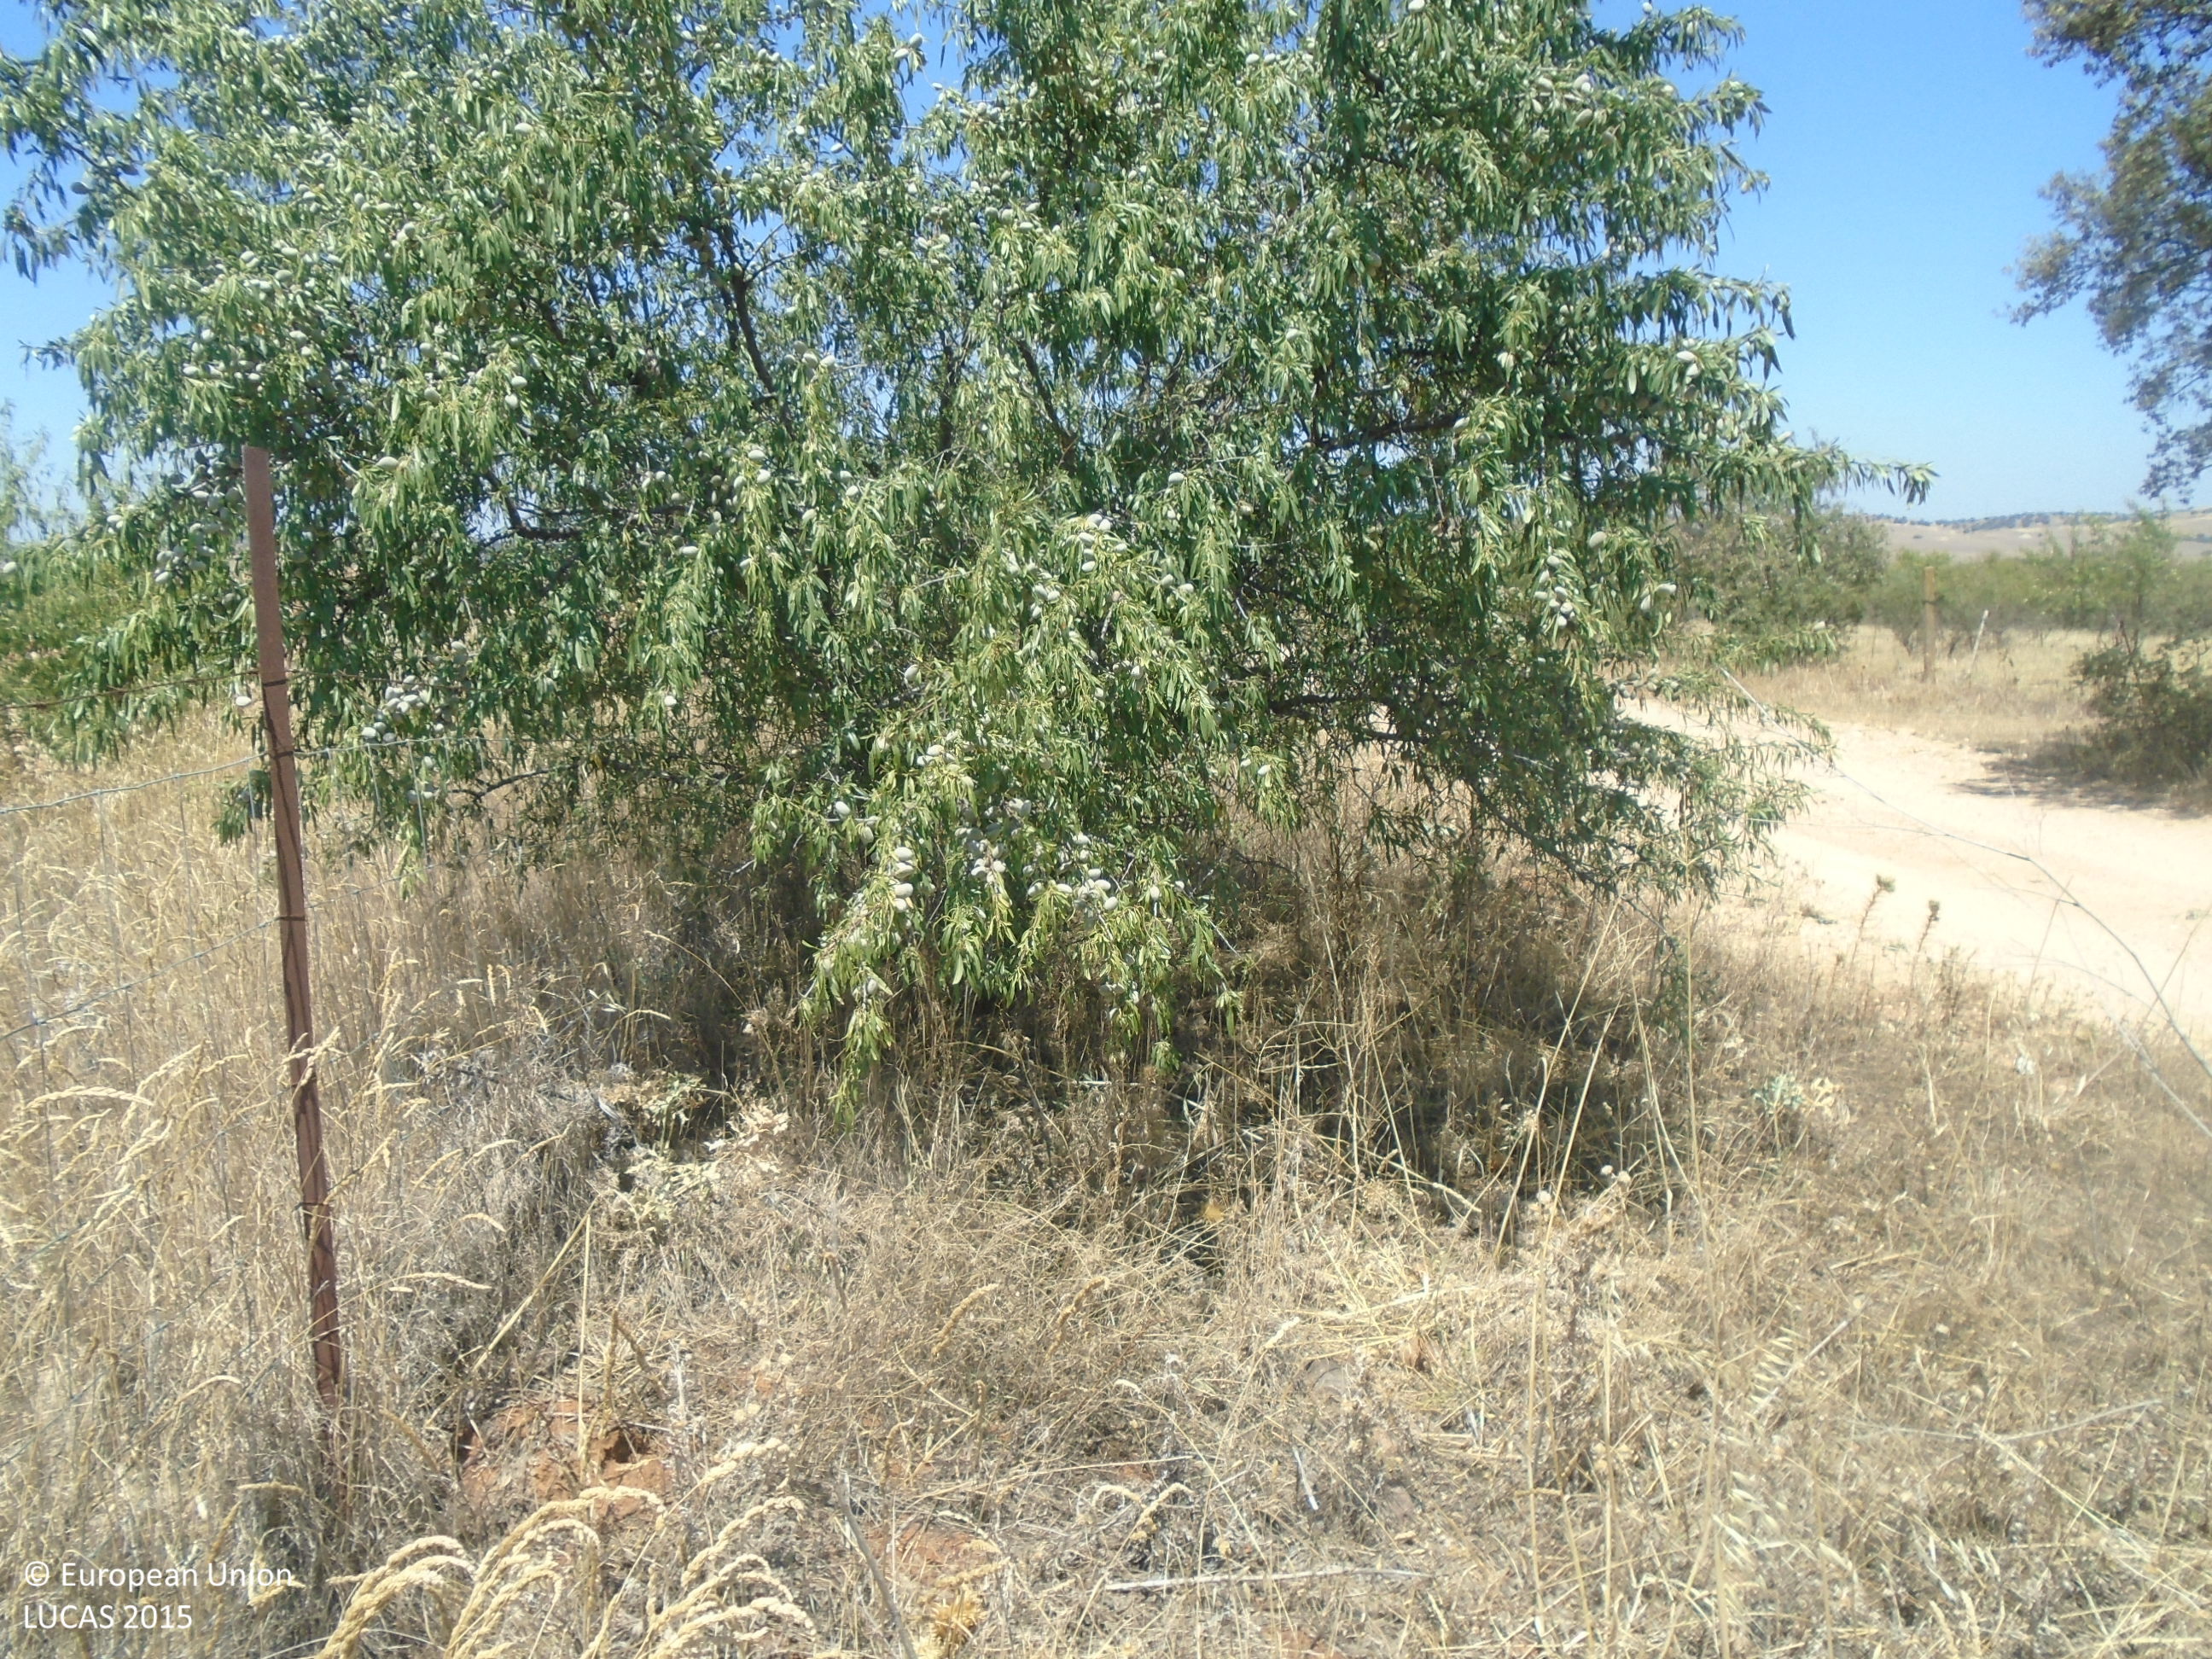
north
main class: Cropland
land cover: Barley
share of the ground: > 75 %
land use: Agriculture (excluding fallow land and kitchen gardens)
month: July
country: ES
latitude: 39.8032
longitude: -4.8915
